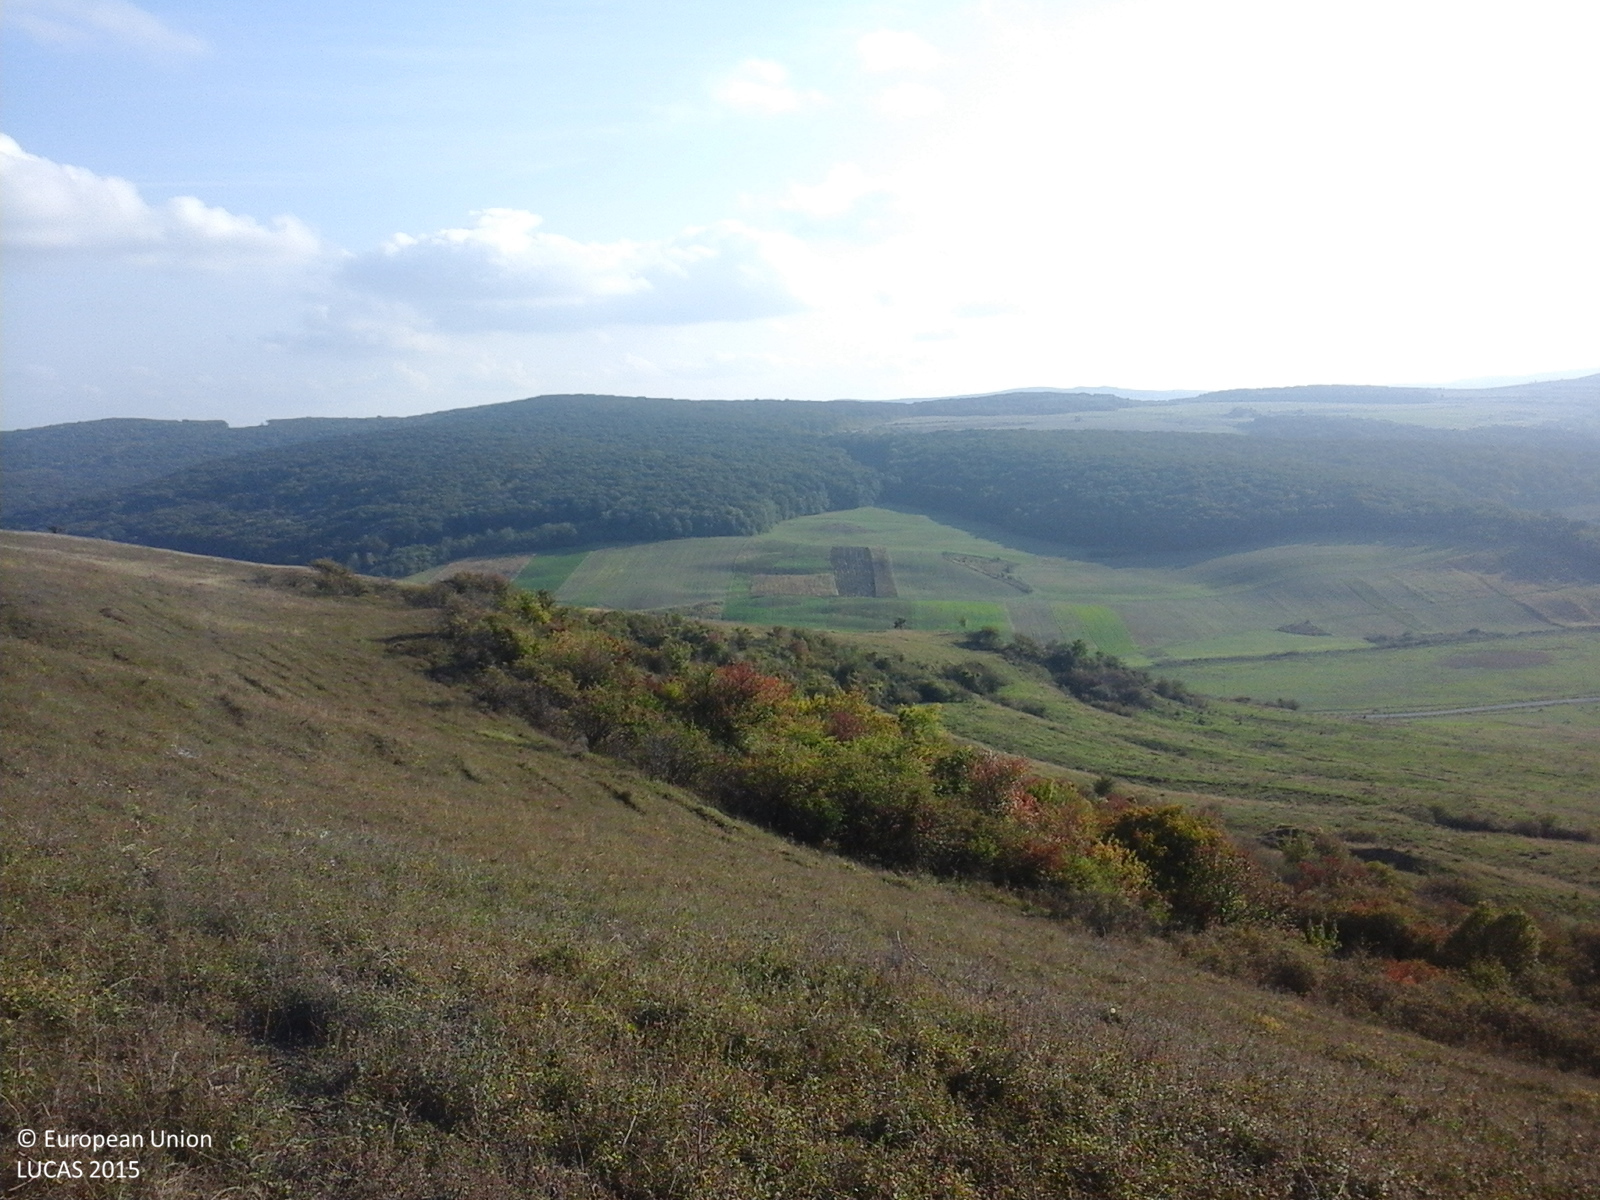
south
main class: Grassland
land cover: Grassland with sparse tree/shrub cover
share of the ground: > 75 %
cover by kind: herbaceous plants 95 %, broadleaved forest trees 5 %
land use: Agriculture (excluding fallow land and kitchen gardens)
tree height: < 5 m
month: October
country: RO
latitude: 46.3614
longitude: 24.1020
